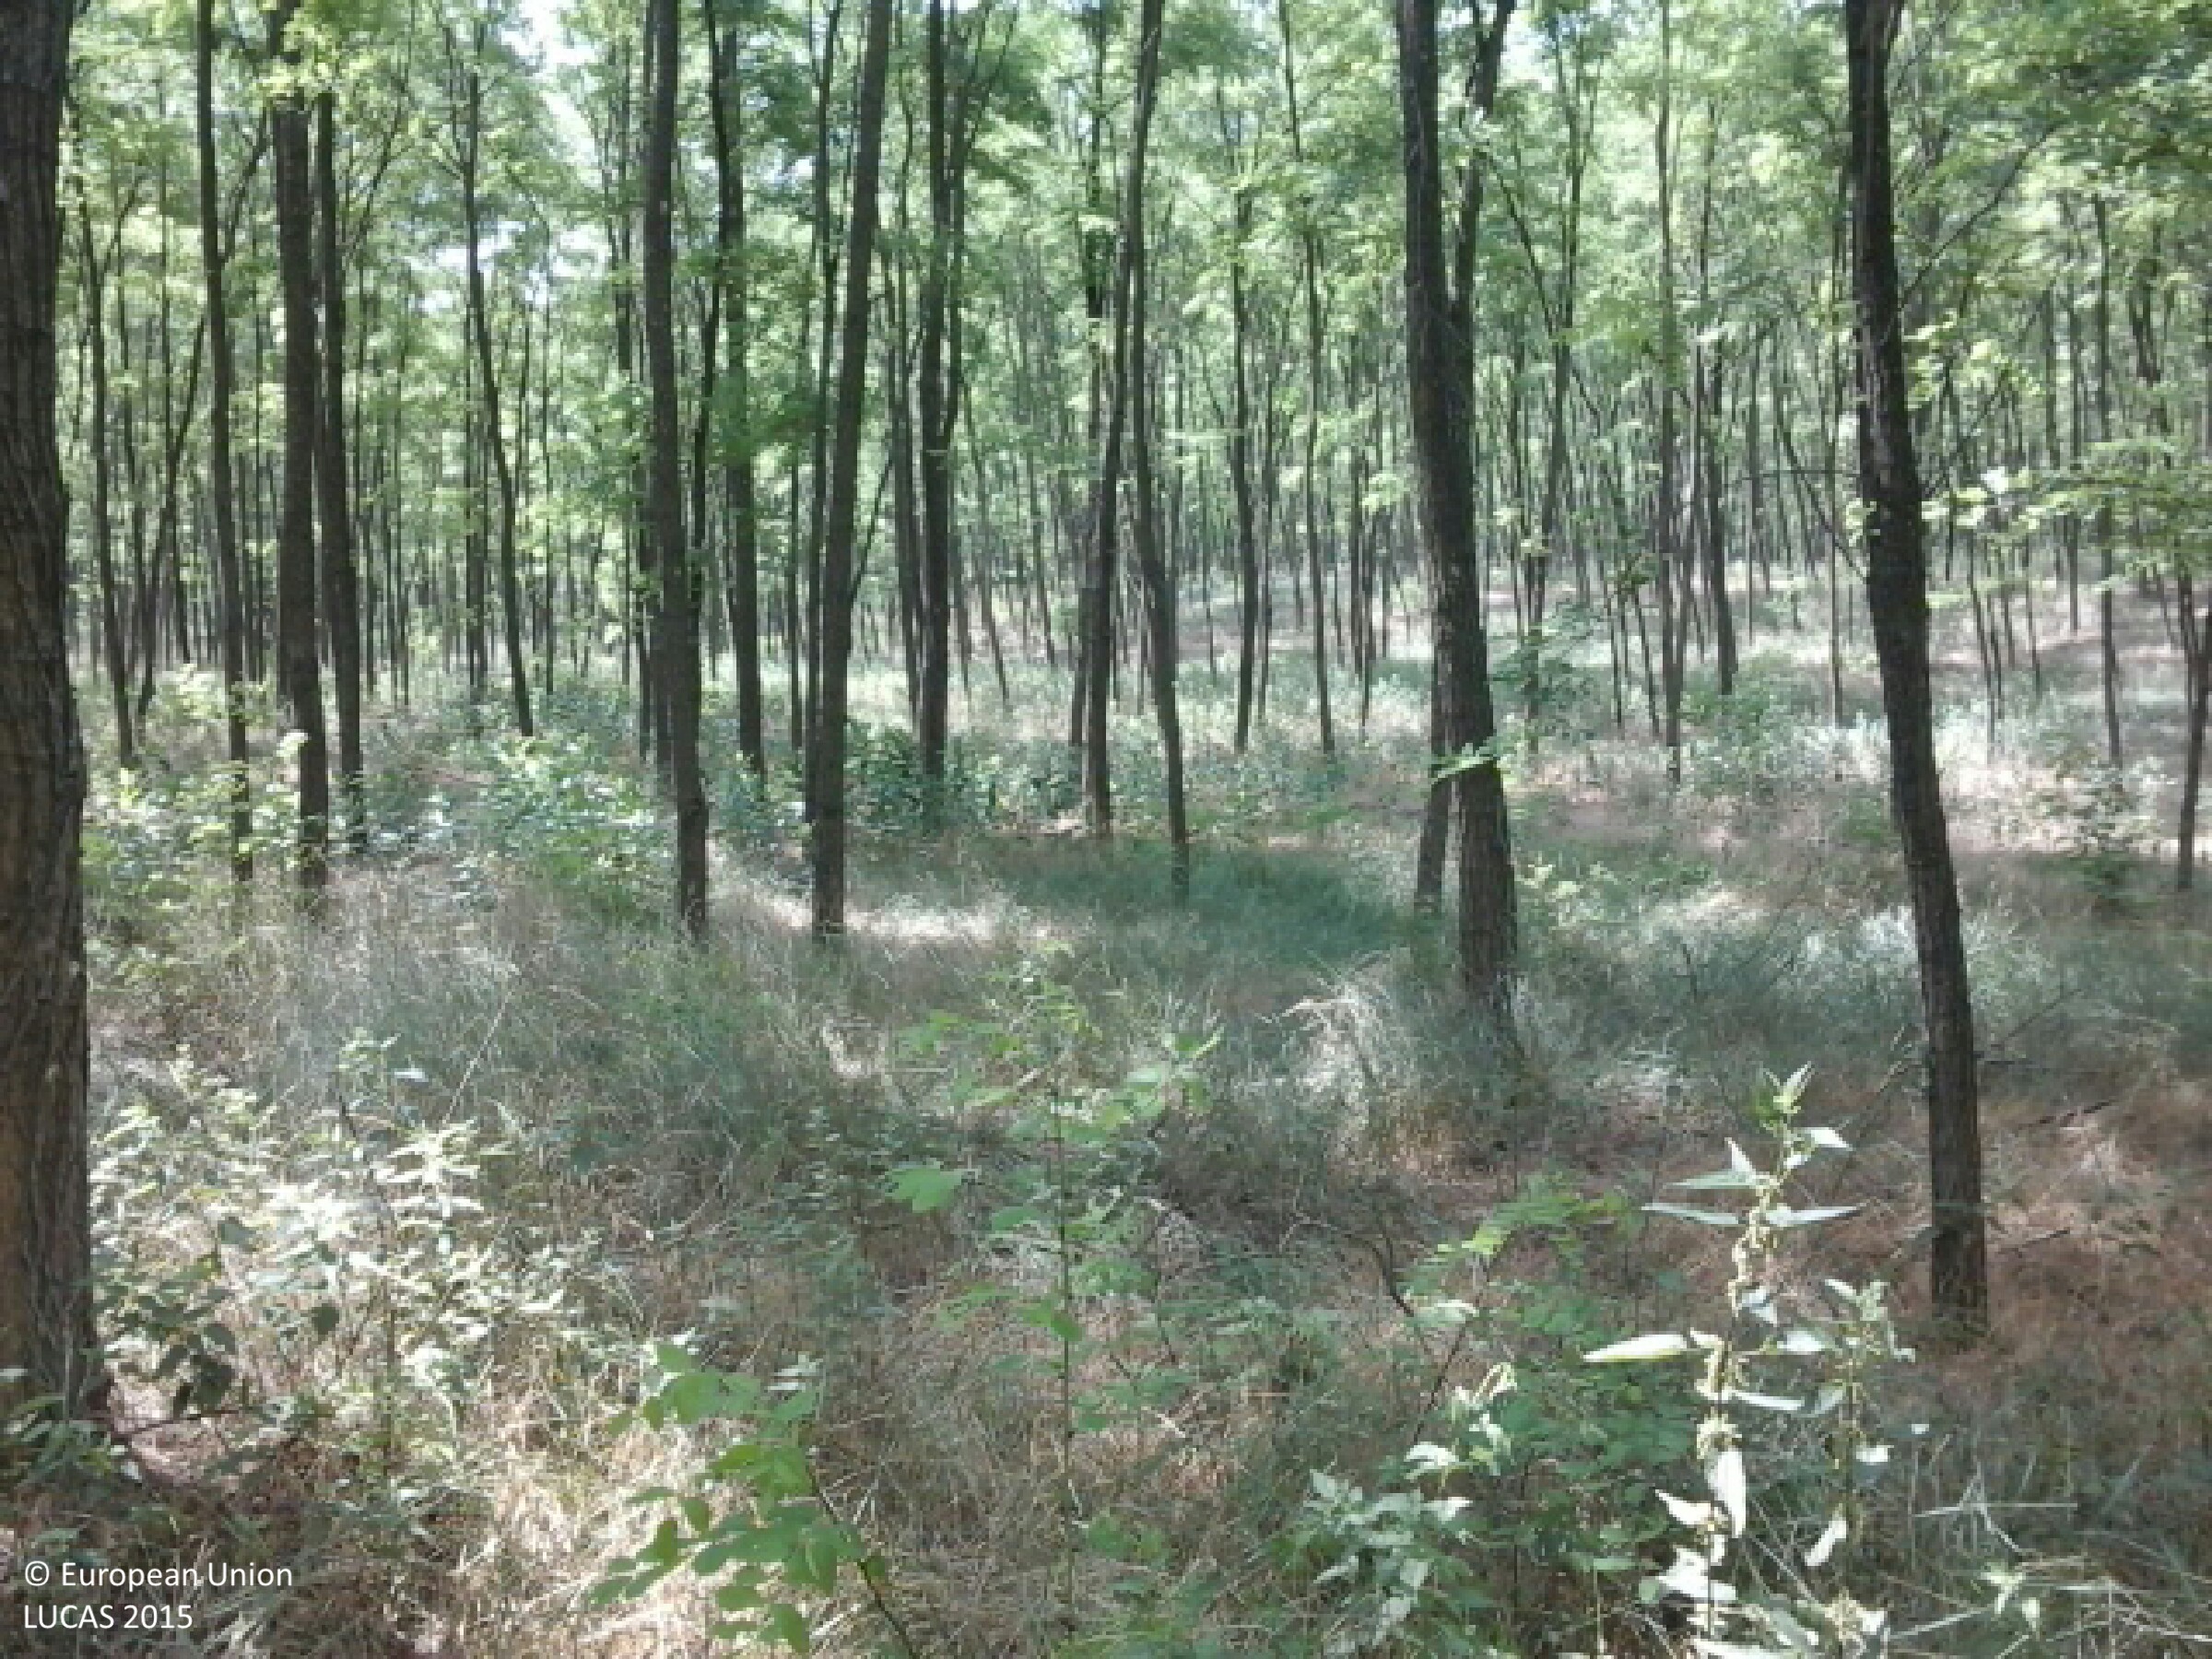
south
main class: Woodland
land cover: Broadleaved woodland
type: mesophytic deciduous forest
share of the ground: > 75 %
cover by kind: broadleaved forest trees 95 %, herbaceous plants 5 %
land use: Forestry
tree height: > 5 m
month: June
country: HU
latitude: 48.0794
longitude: 22.1216
